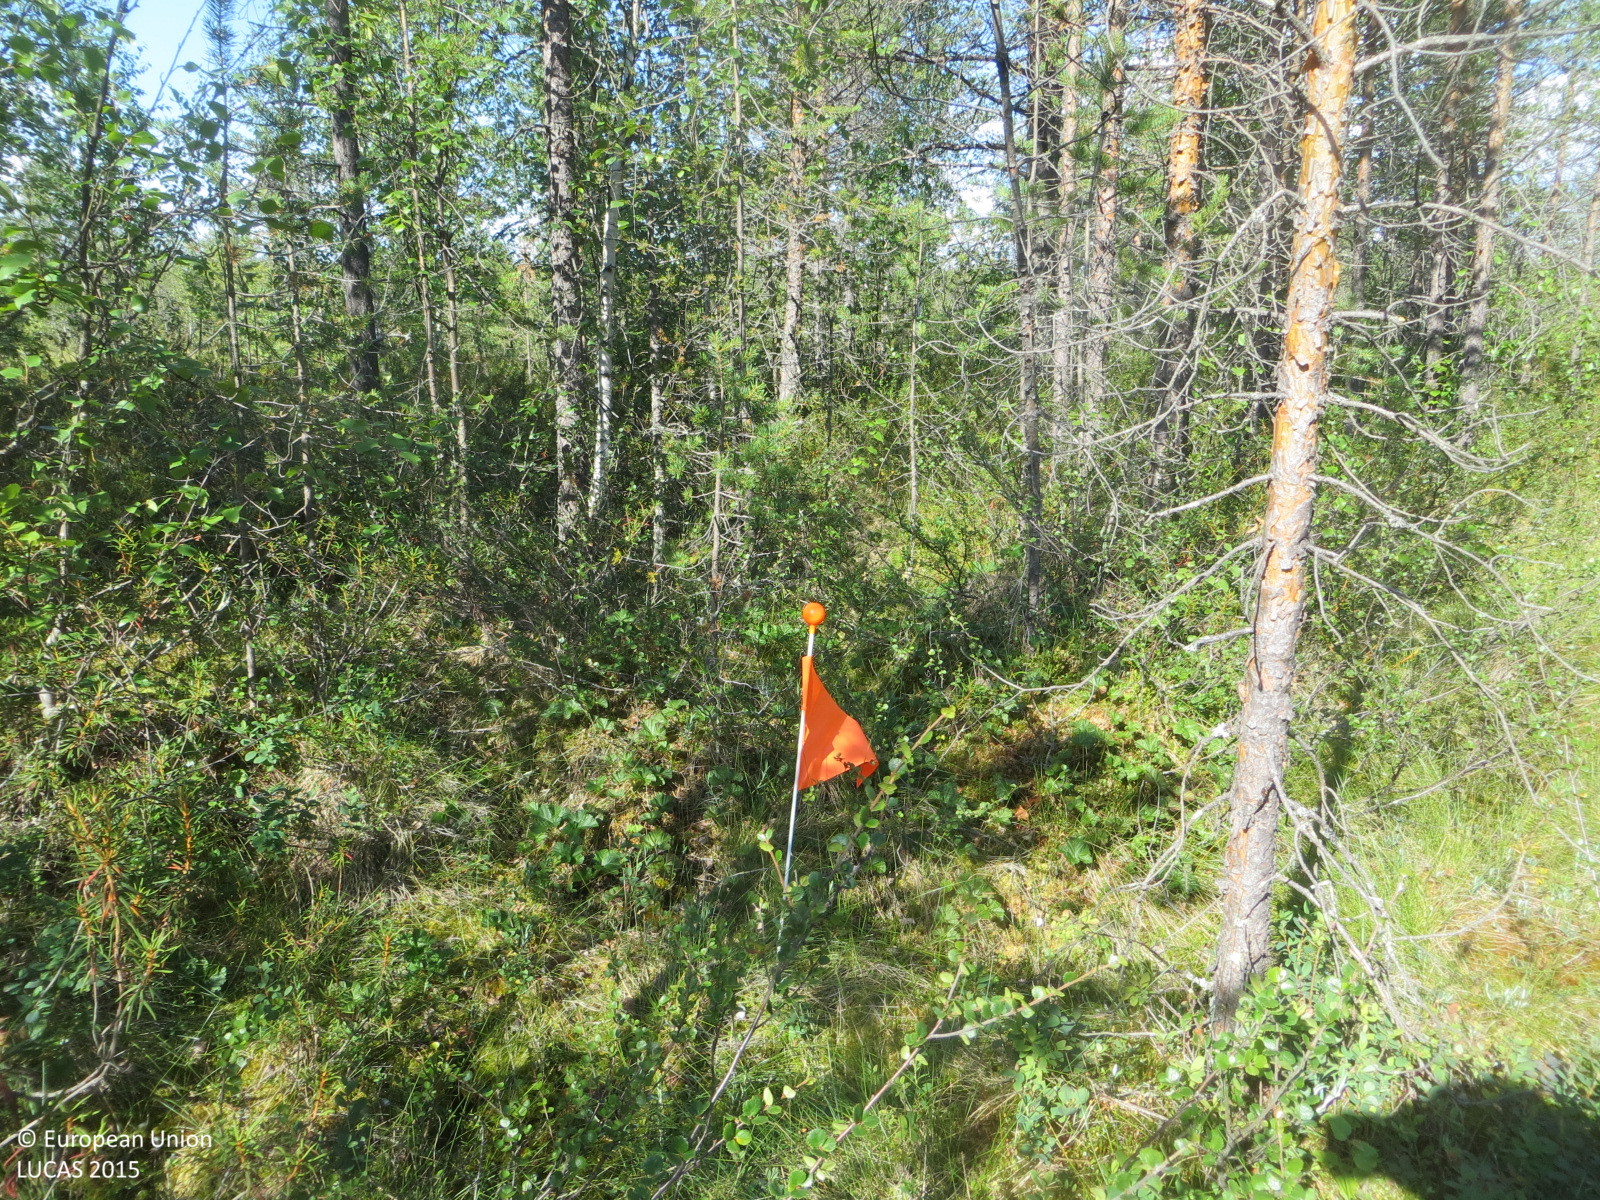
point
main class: Woodland
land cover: Pine dominated mixed woodland
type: mire and swamp forests
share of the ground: 50 - 75 %
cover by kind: coniferous forest trees 40 %, shrubs 40 %, broadleaved forest trees 20 %
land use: Forestry
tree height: > 5 m
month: July
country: FI
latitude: 66.0564
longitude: 24.0202
